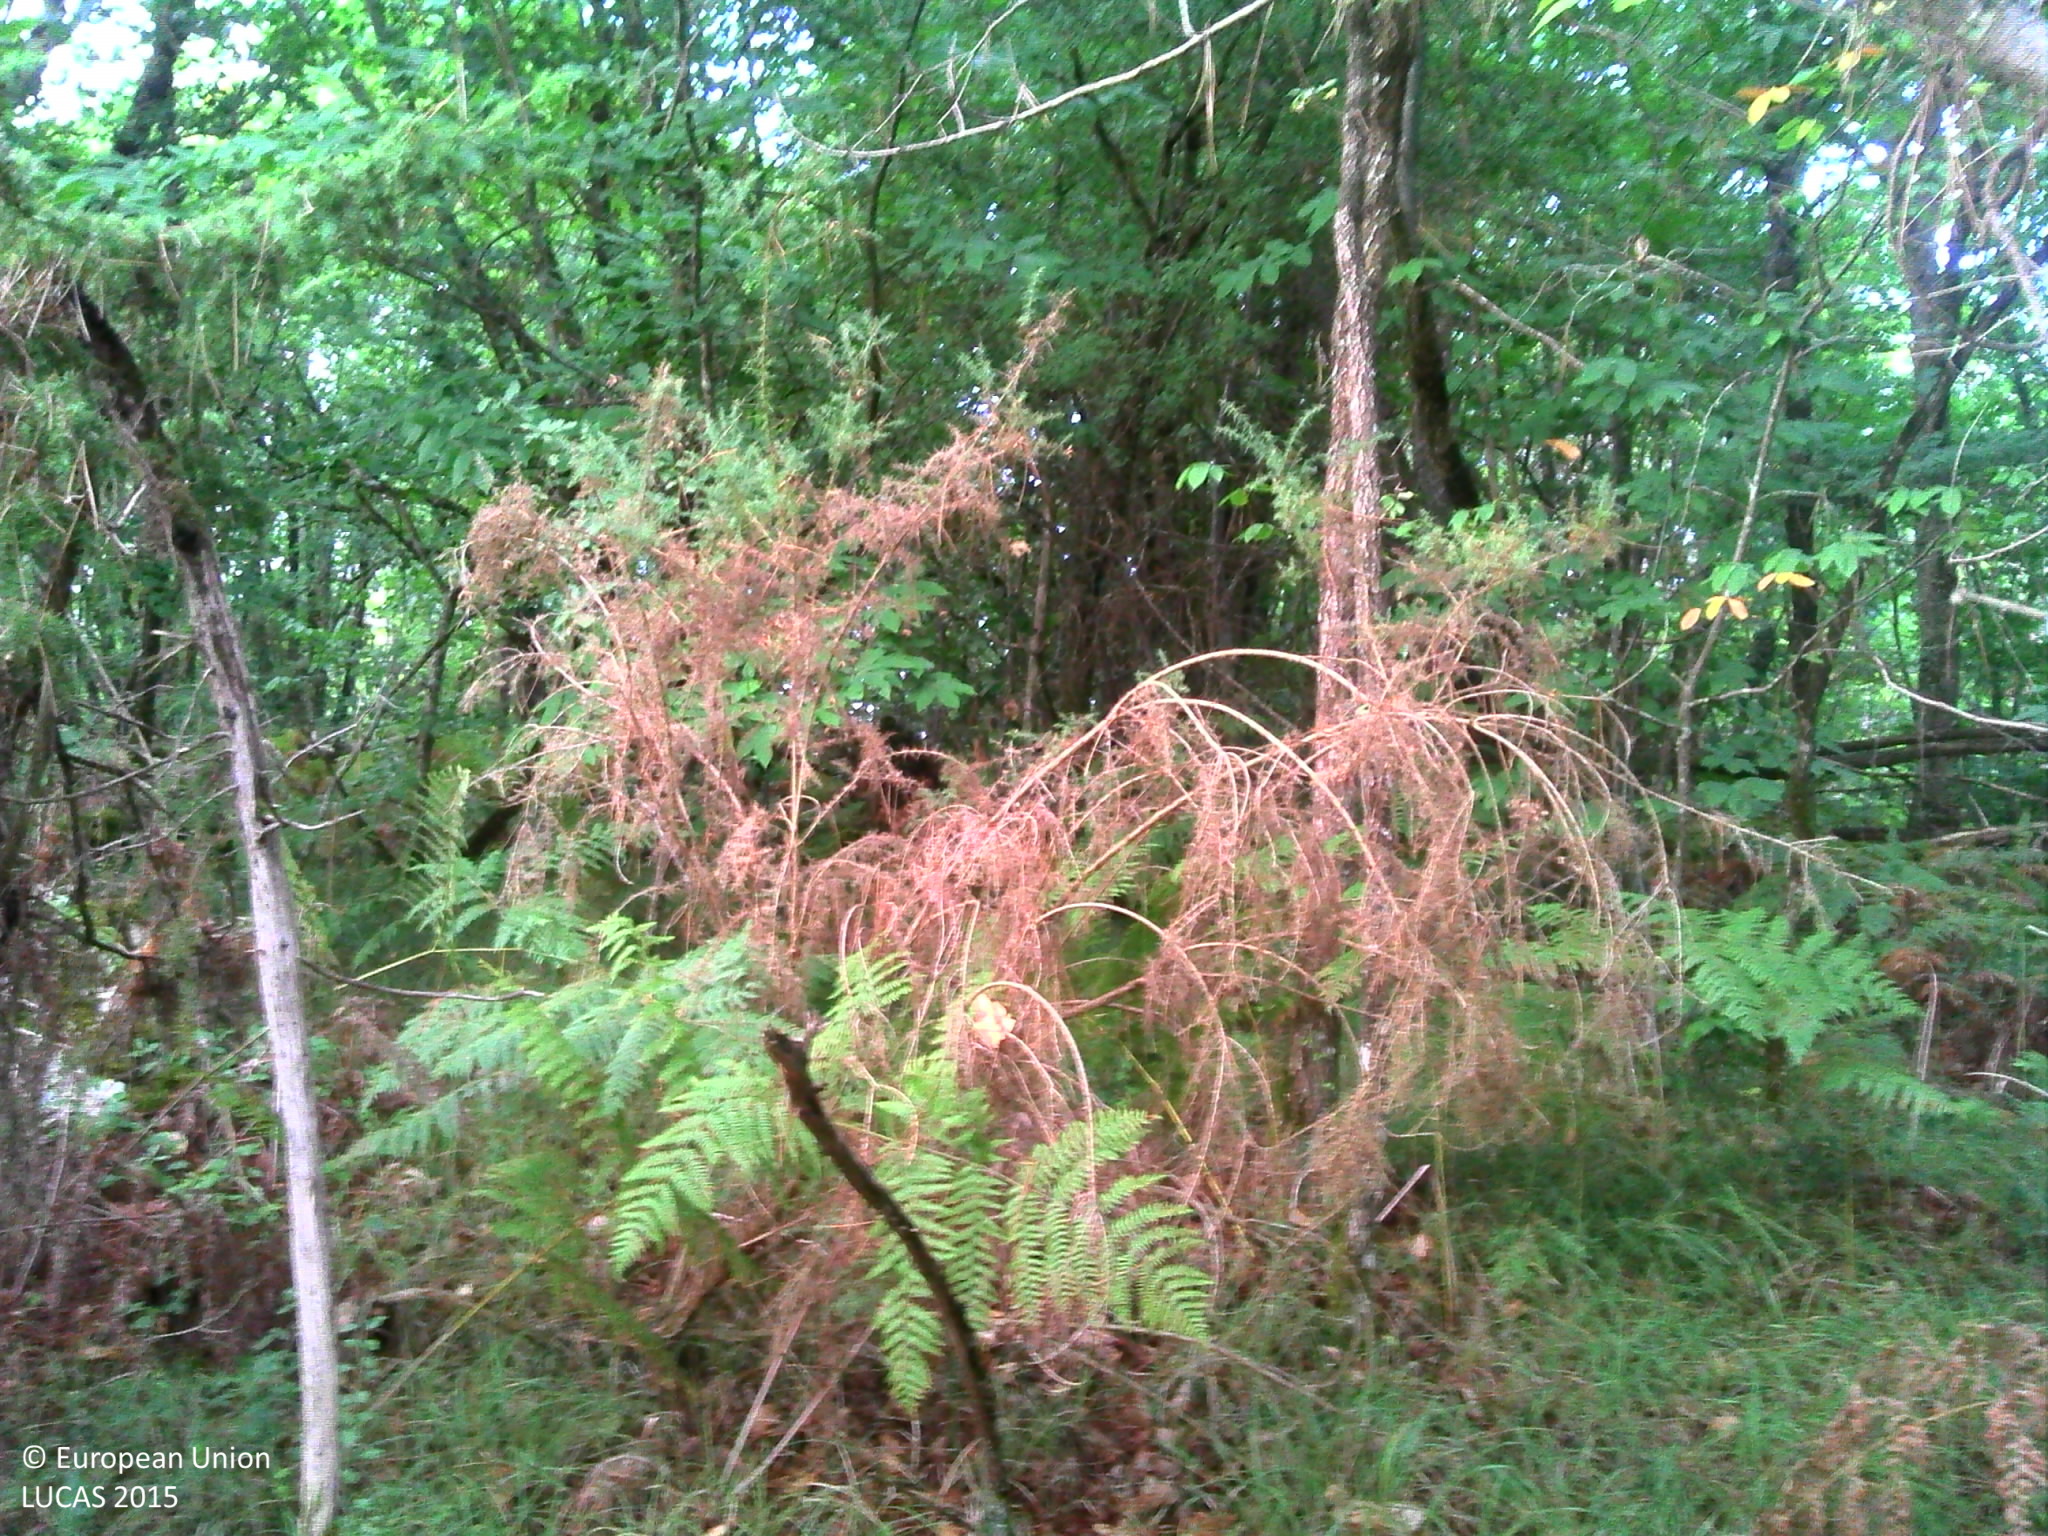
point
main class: Woodland
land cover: Pine dominated mixed woodland
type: thermophilous deciduous forest
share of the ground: > 75 %
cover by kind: broadleaved forest trees 40 %, coniferous forest trees 20 %, herbaceous plants 20 %, lichens and mosses 10 %, consolidated bare surface 10 %
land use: Forestry
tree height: > 5 m
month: August
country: FR
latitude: 45.4395
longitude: 0.7206
